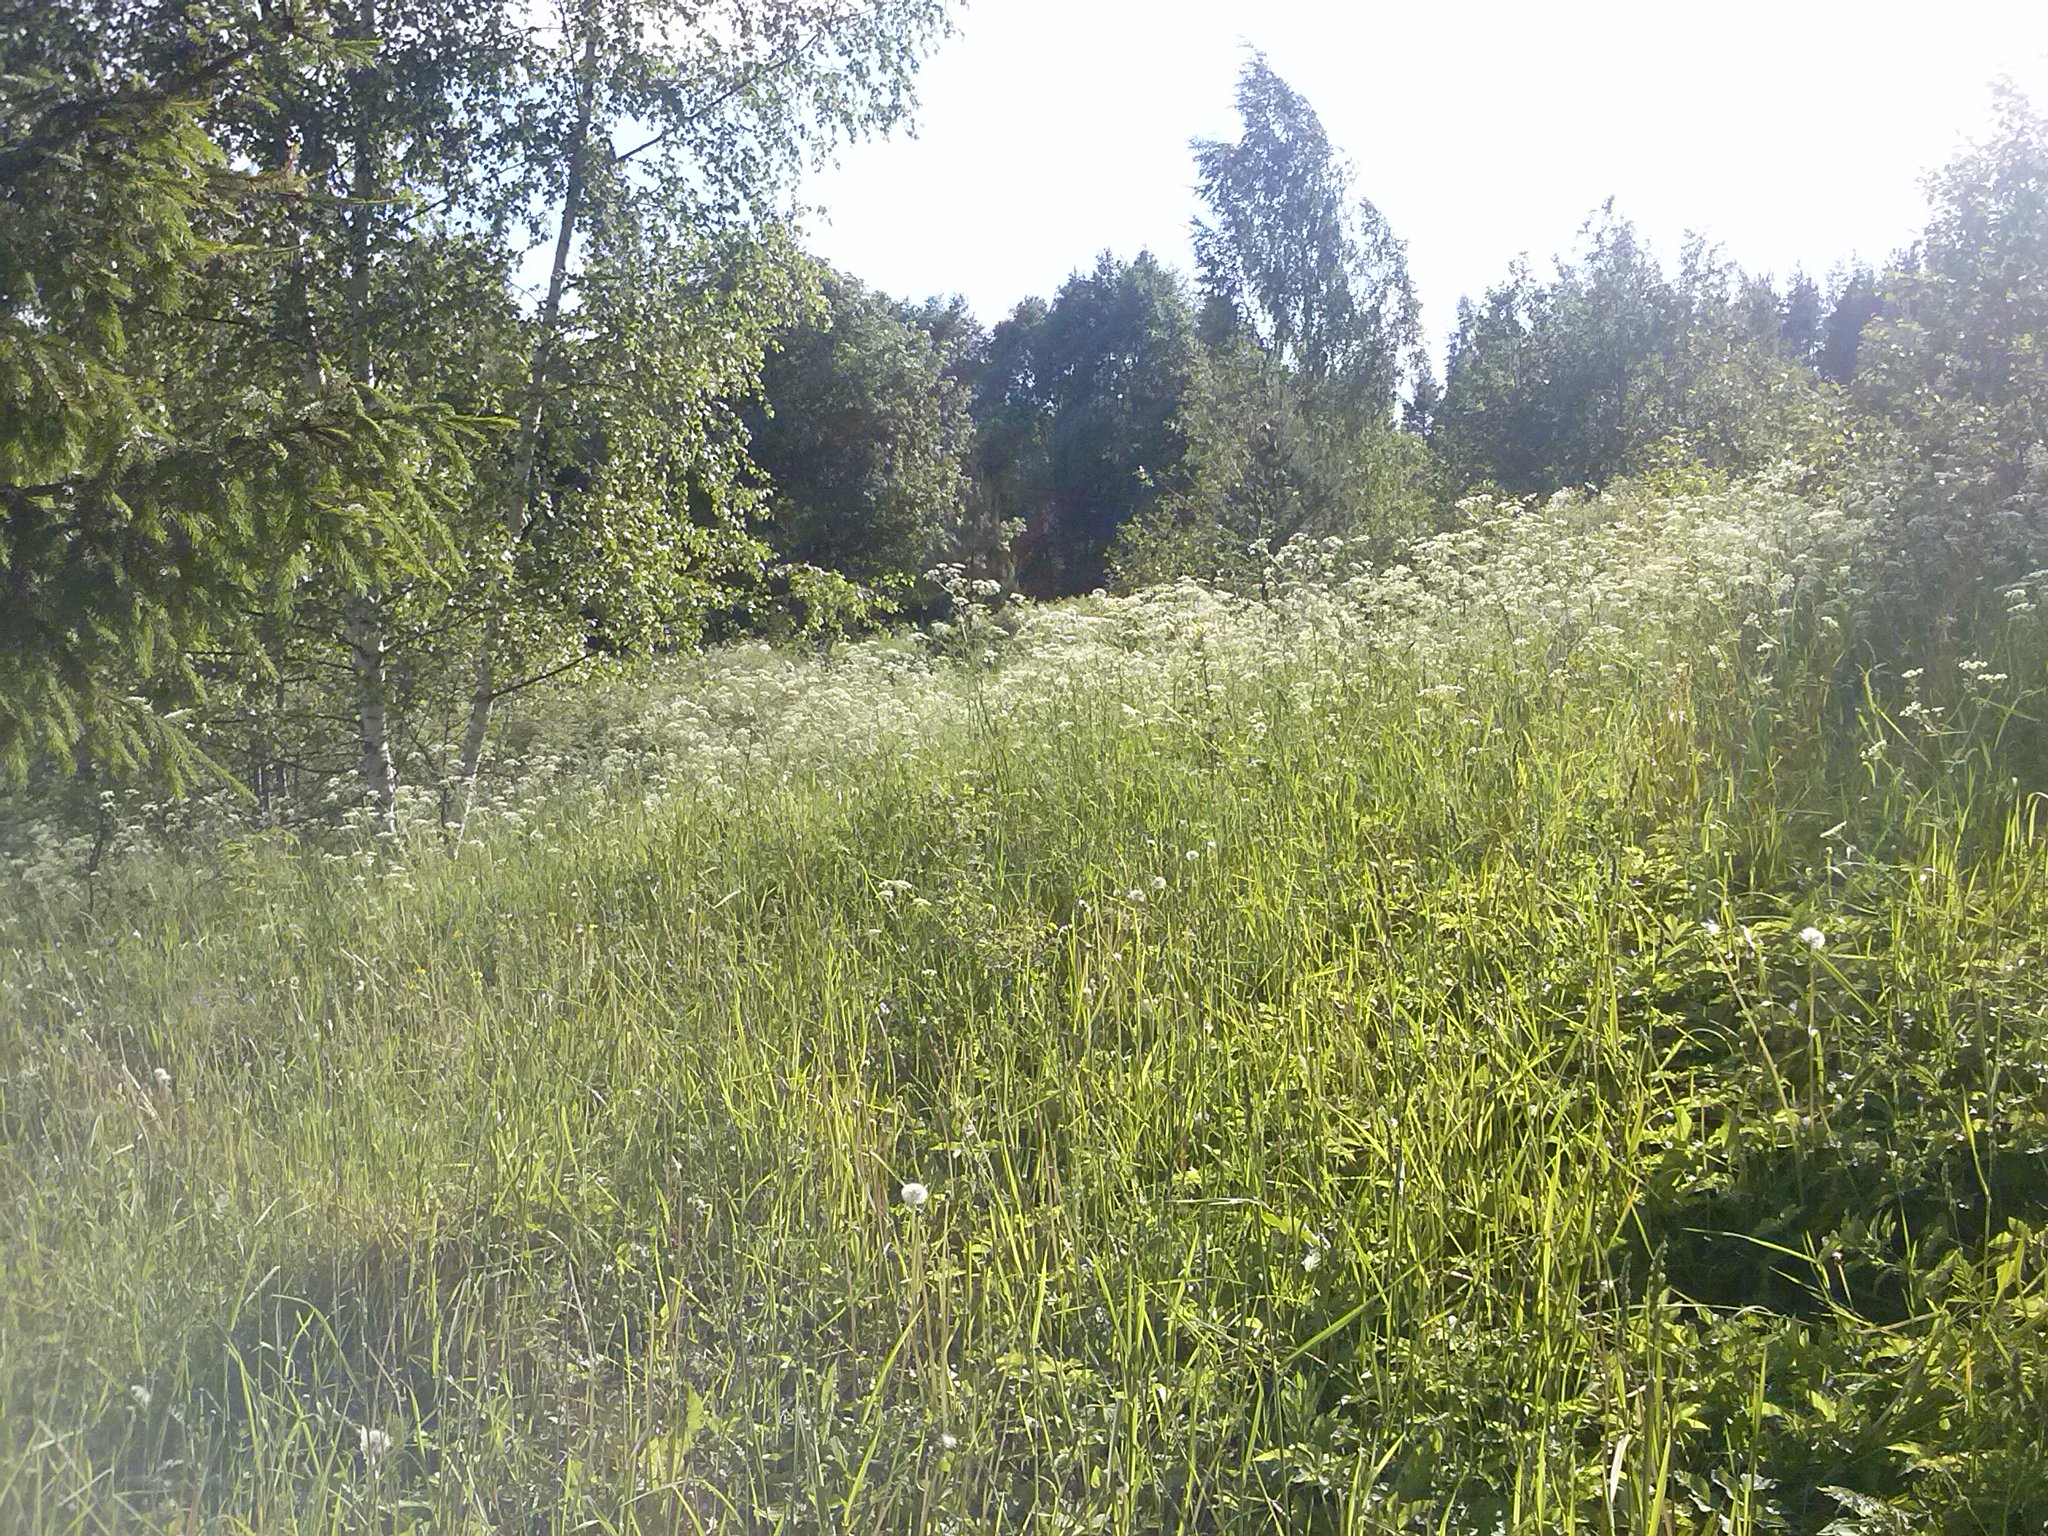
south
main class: Grassland
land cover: Grassland with sparse tree/shrub cover
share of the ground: > 75 %
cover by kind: herbaceous plants 90 %, coniferous forest trees 5 %, shrubs 5 %
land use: Forestry
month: June
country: LV
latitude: 56.3530
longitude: 27.6461
